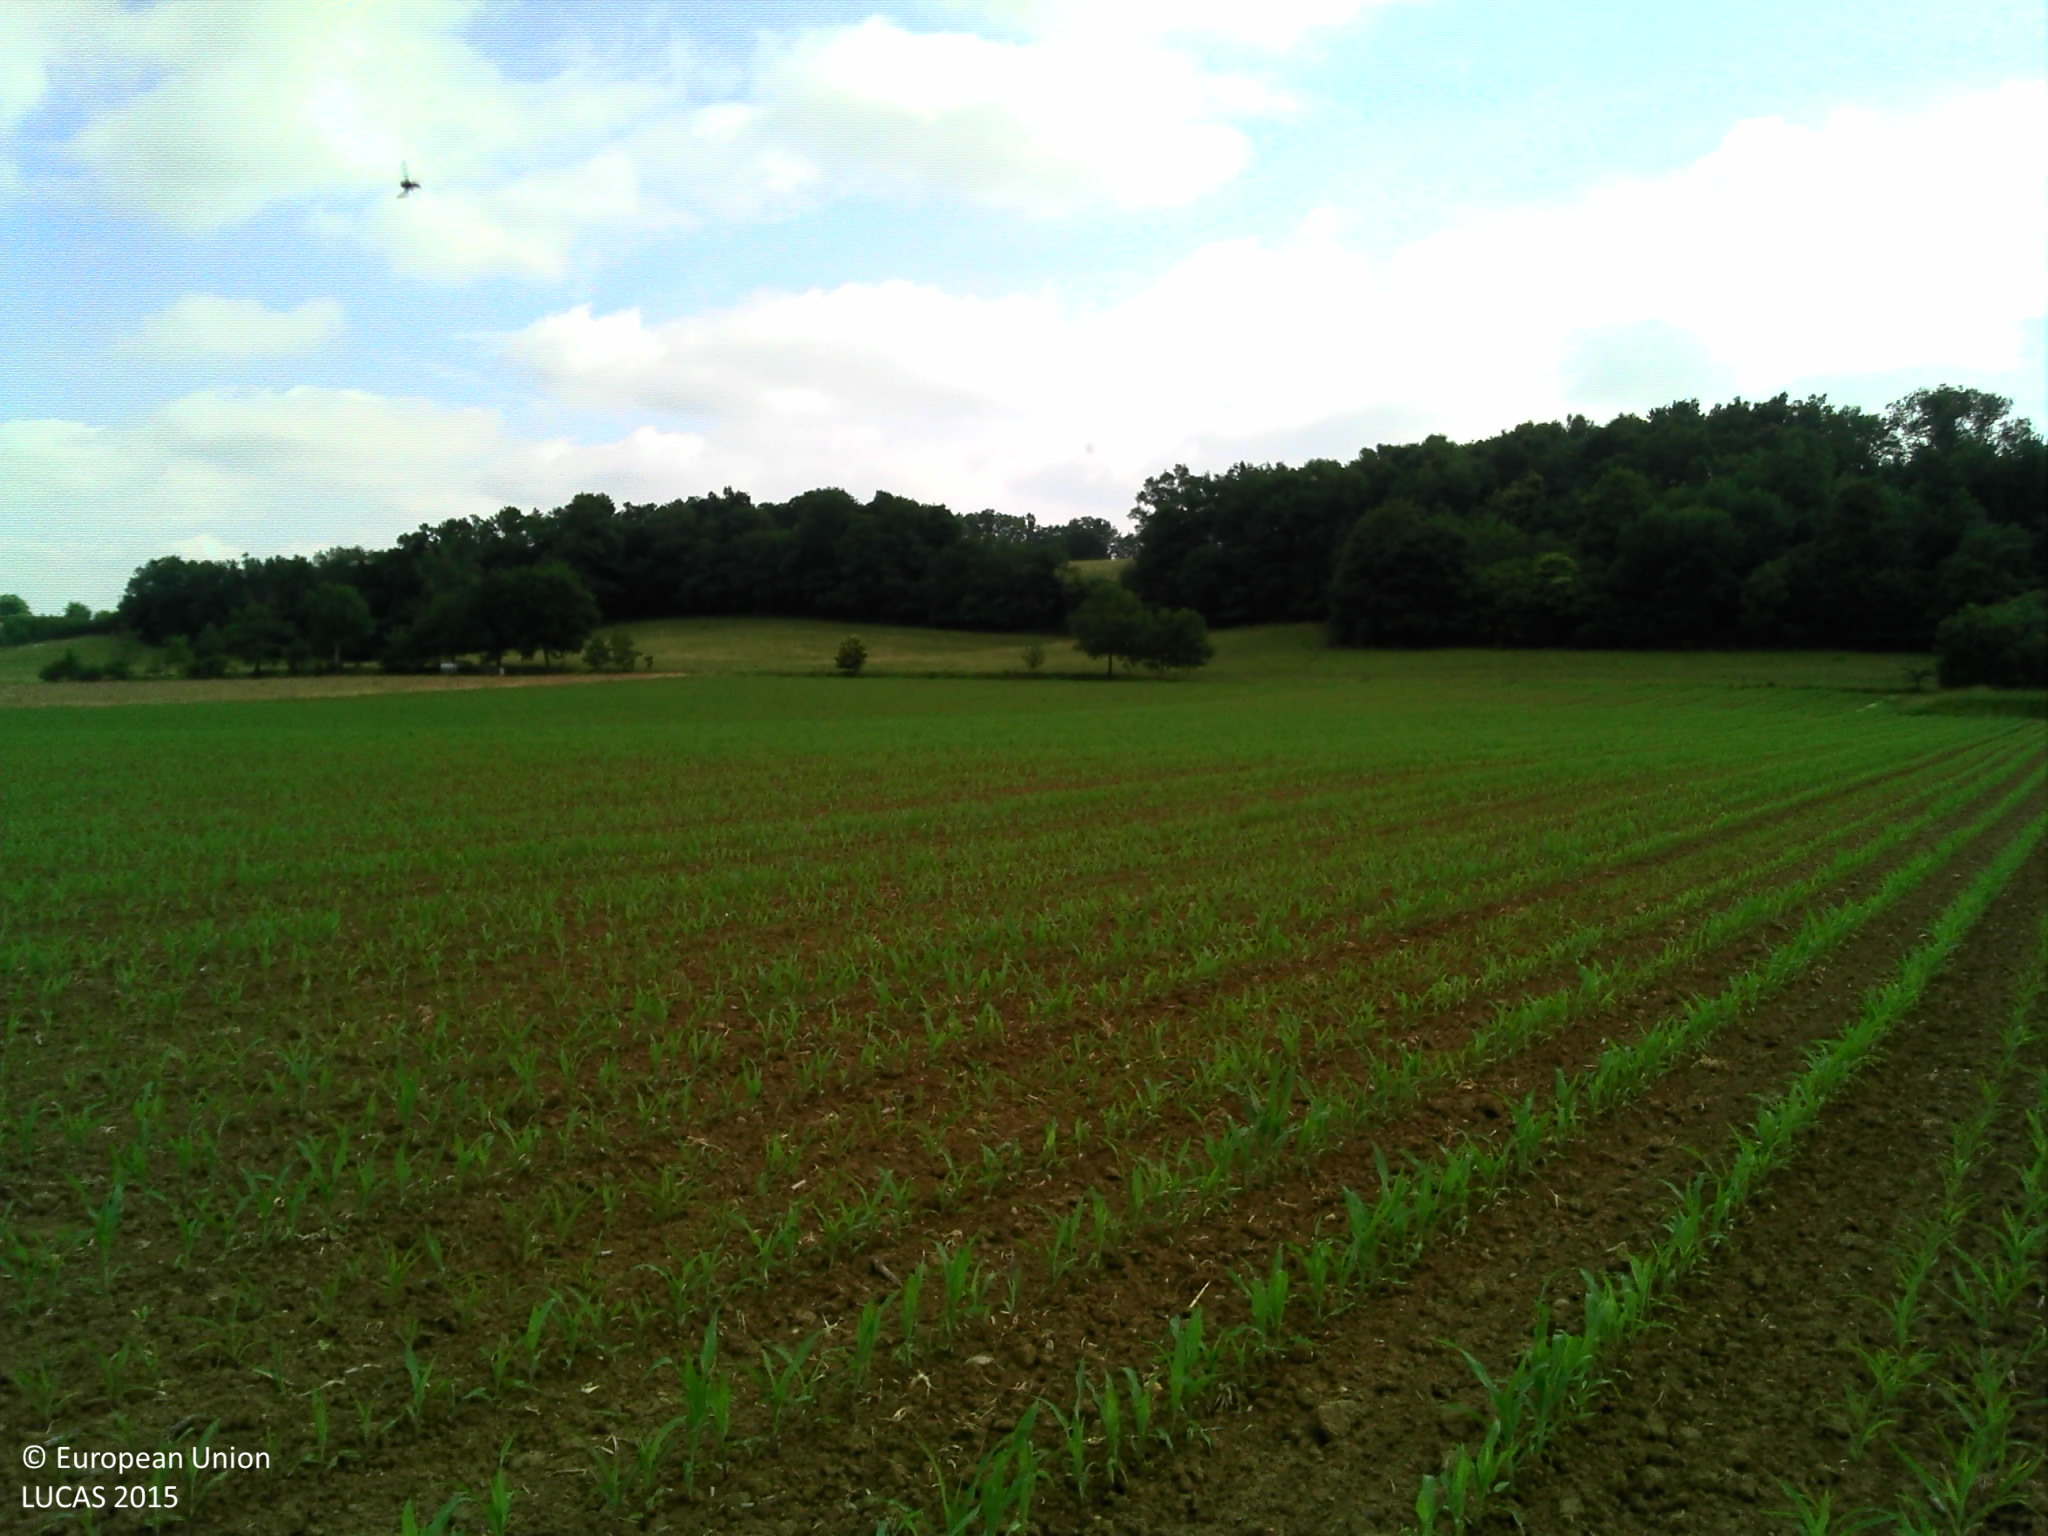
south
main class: Cropland
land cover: Maize
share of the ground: 10 - 25 %
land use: Agriculture (excluding fallow land and kitchen gardens)
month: June
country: FR
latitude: 43.6100
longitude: -0.2046
